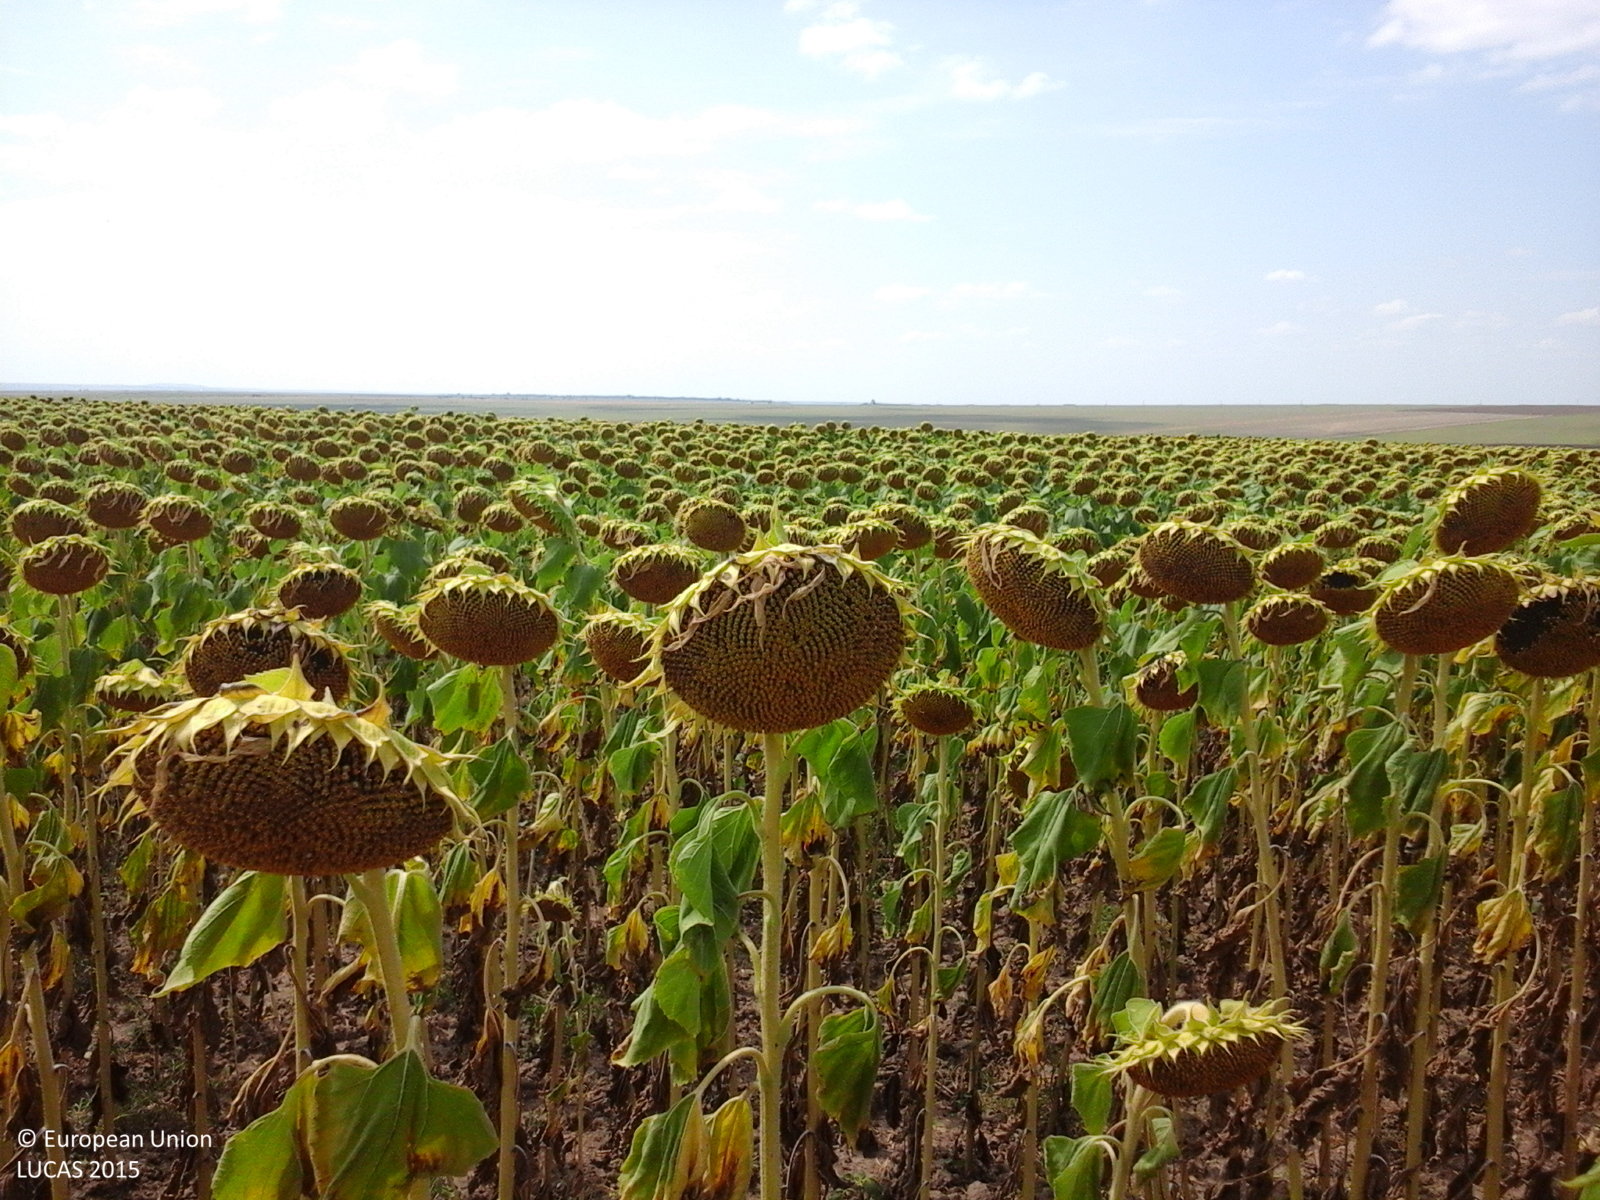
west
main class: Cropland
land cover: Sunflower
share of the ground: > 75 %
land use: Agriculture (excluding fallow land and kitchen gardens)
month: August
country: RO
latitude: 44.7945
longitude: 28.1800
